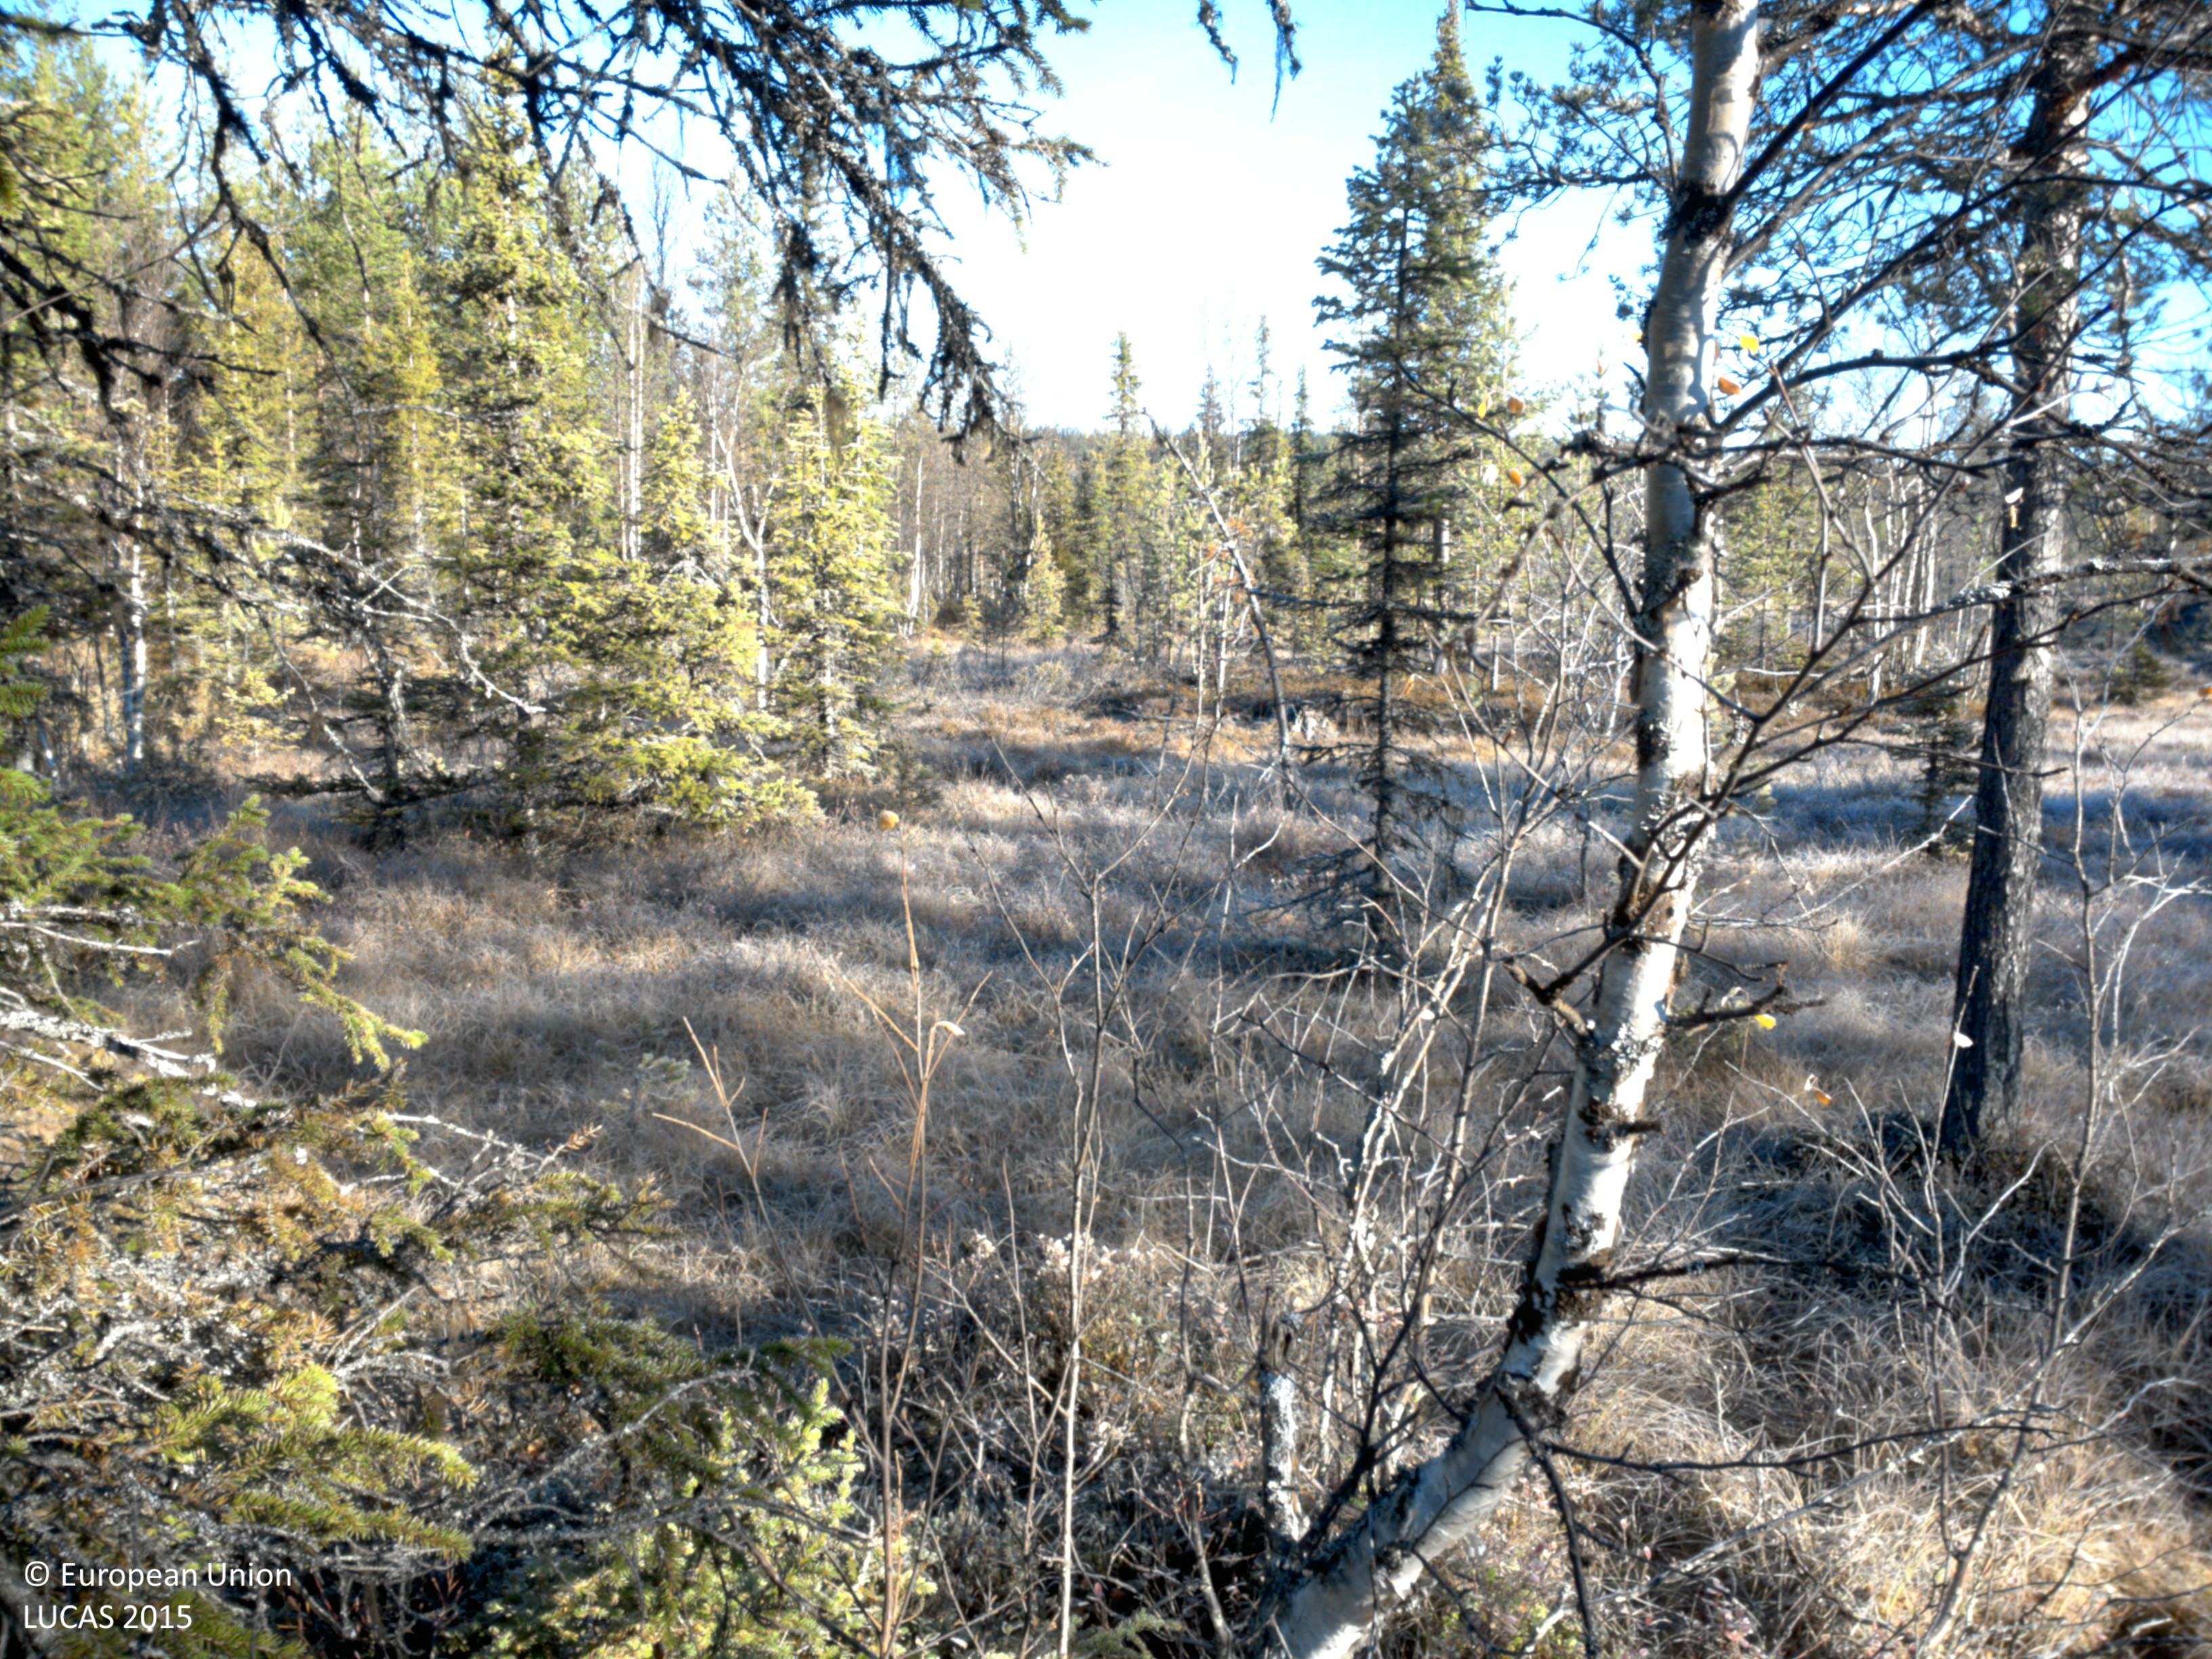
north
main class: Woodland
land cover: Spruce dominated mixed woodland
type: mire and swamp forests
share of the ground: 25 - 50 %
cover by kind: coniferous forest trees 30 %, shrubs 25 %, broadleaved forest trees 20 %, lichens and mosses 15 %, herbaceous plants 10 %
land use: Forestry
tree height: > 5 m
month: October
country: SE
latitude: 64.7530
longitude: 17.7612
